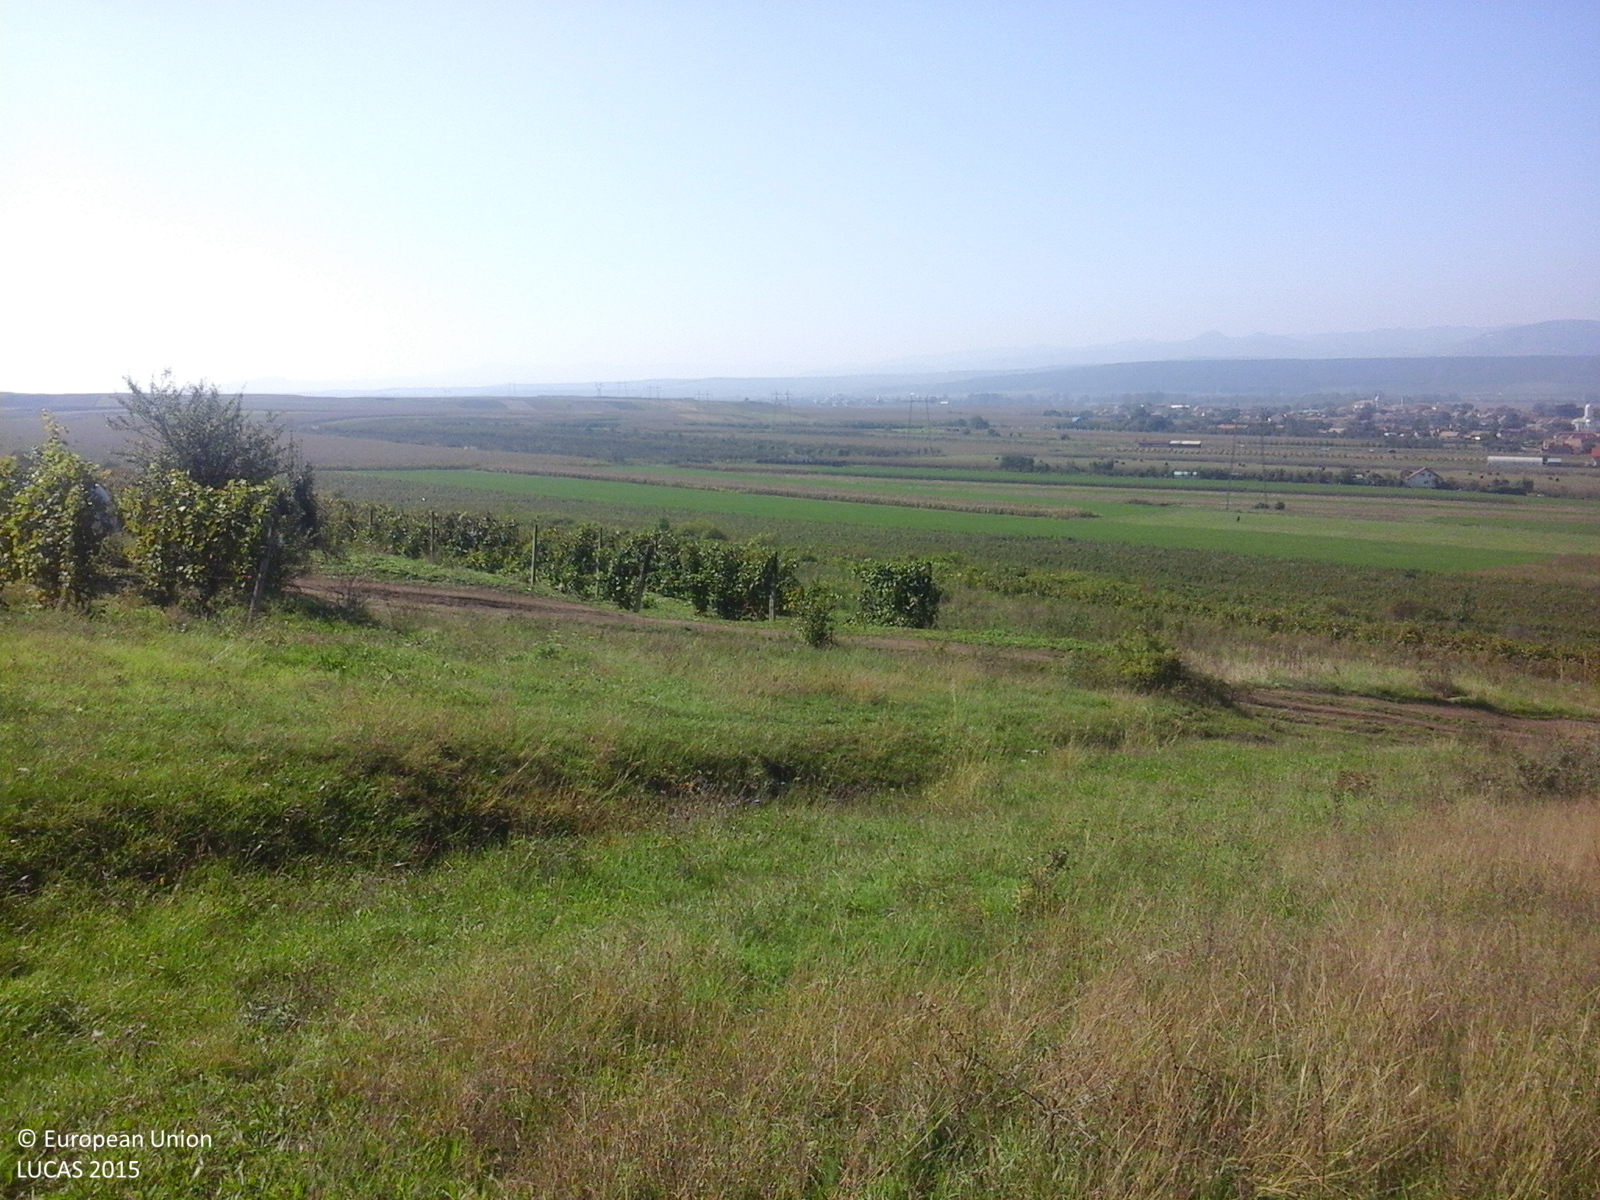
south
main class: Cropland
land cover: Vineyards
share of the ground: > 75 %
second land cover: Grassland without tree/shrub cover
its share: > 75 %
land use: Agriculture (excluding fallow land and kitchen gardens)
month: October
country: RO
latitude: 46.2959
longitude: 23.7670
